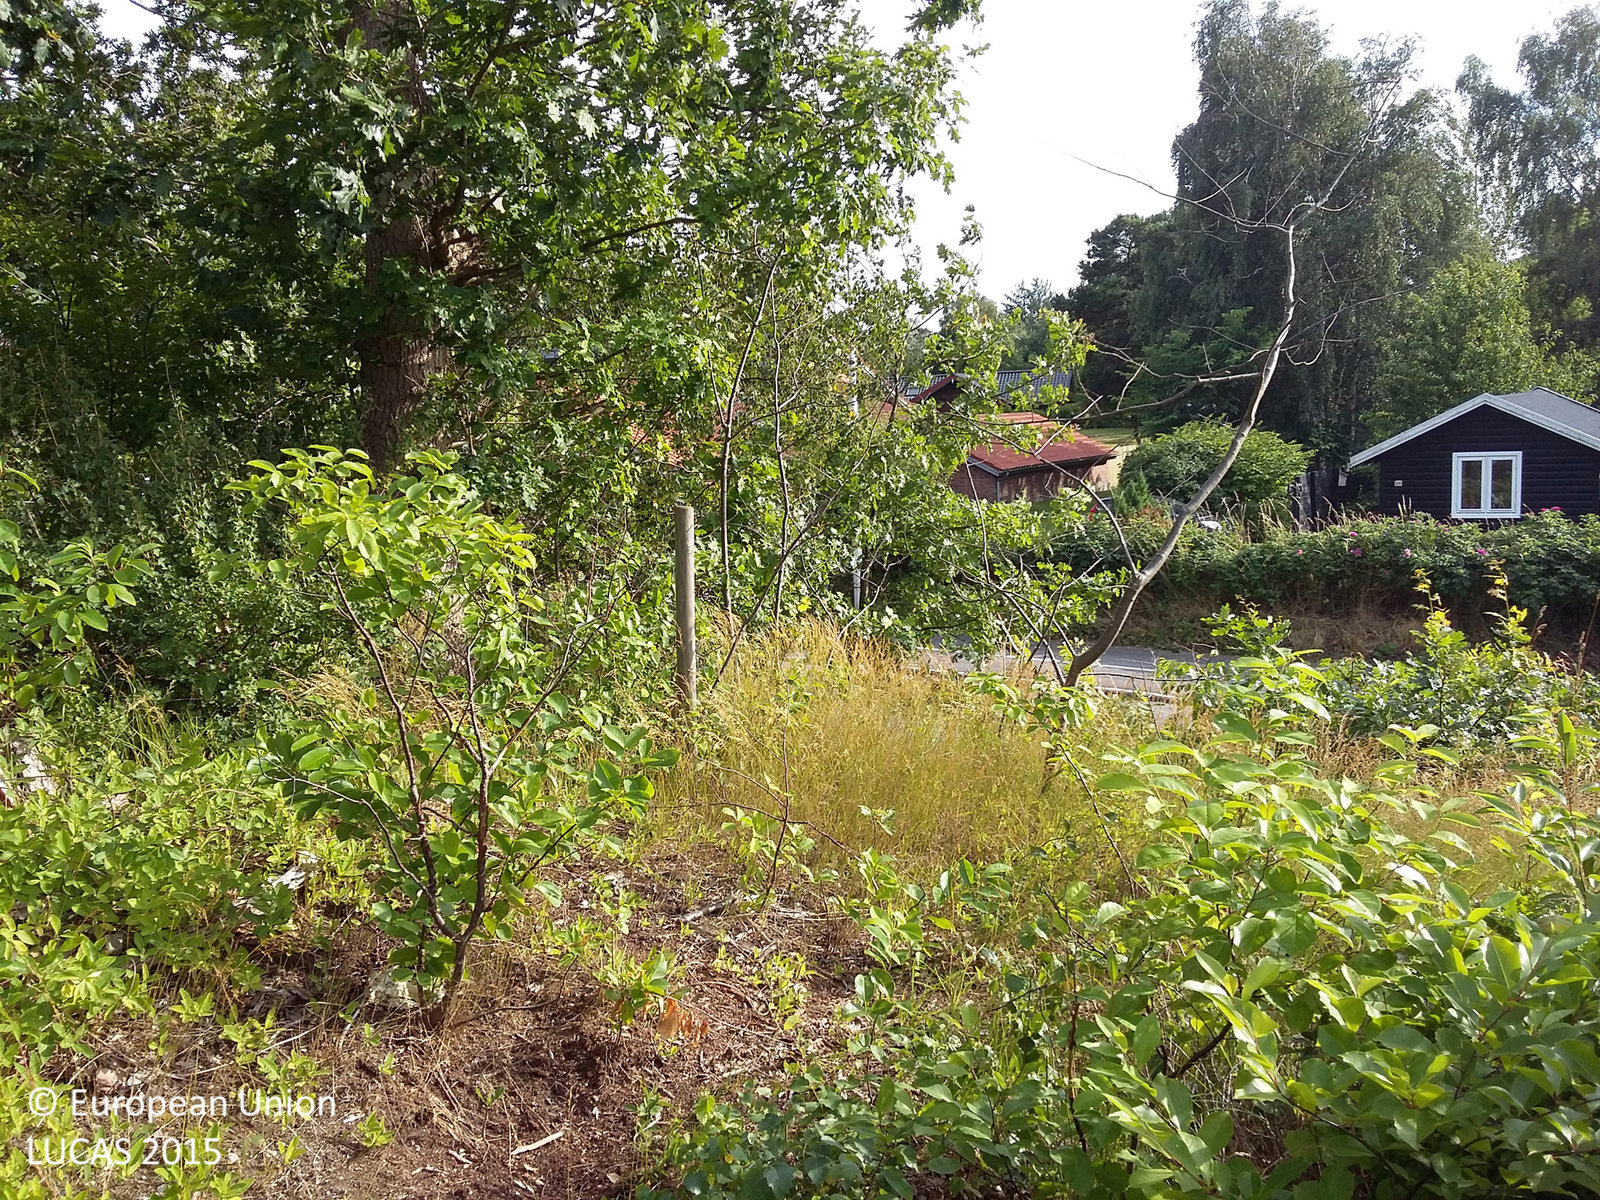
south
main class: Woodland
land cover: Broadleaved woodland
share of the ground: > 75 %
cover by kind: broadleaved forest trees 80 %, herbaceous plants 20 %
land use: Residential
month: July
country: DK
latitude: 56.0975
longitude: 12.1680
